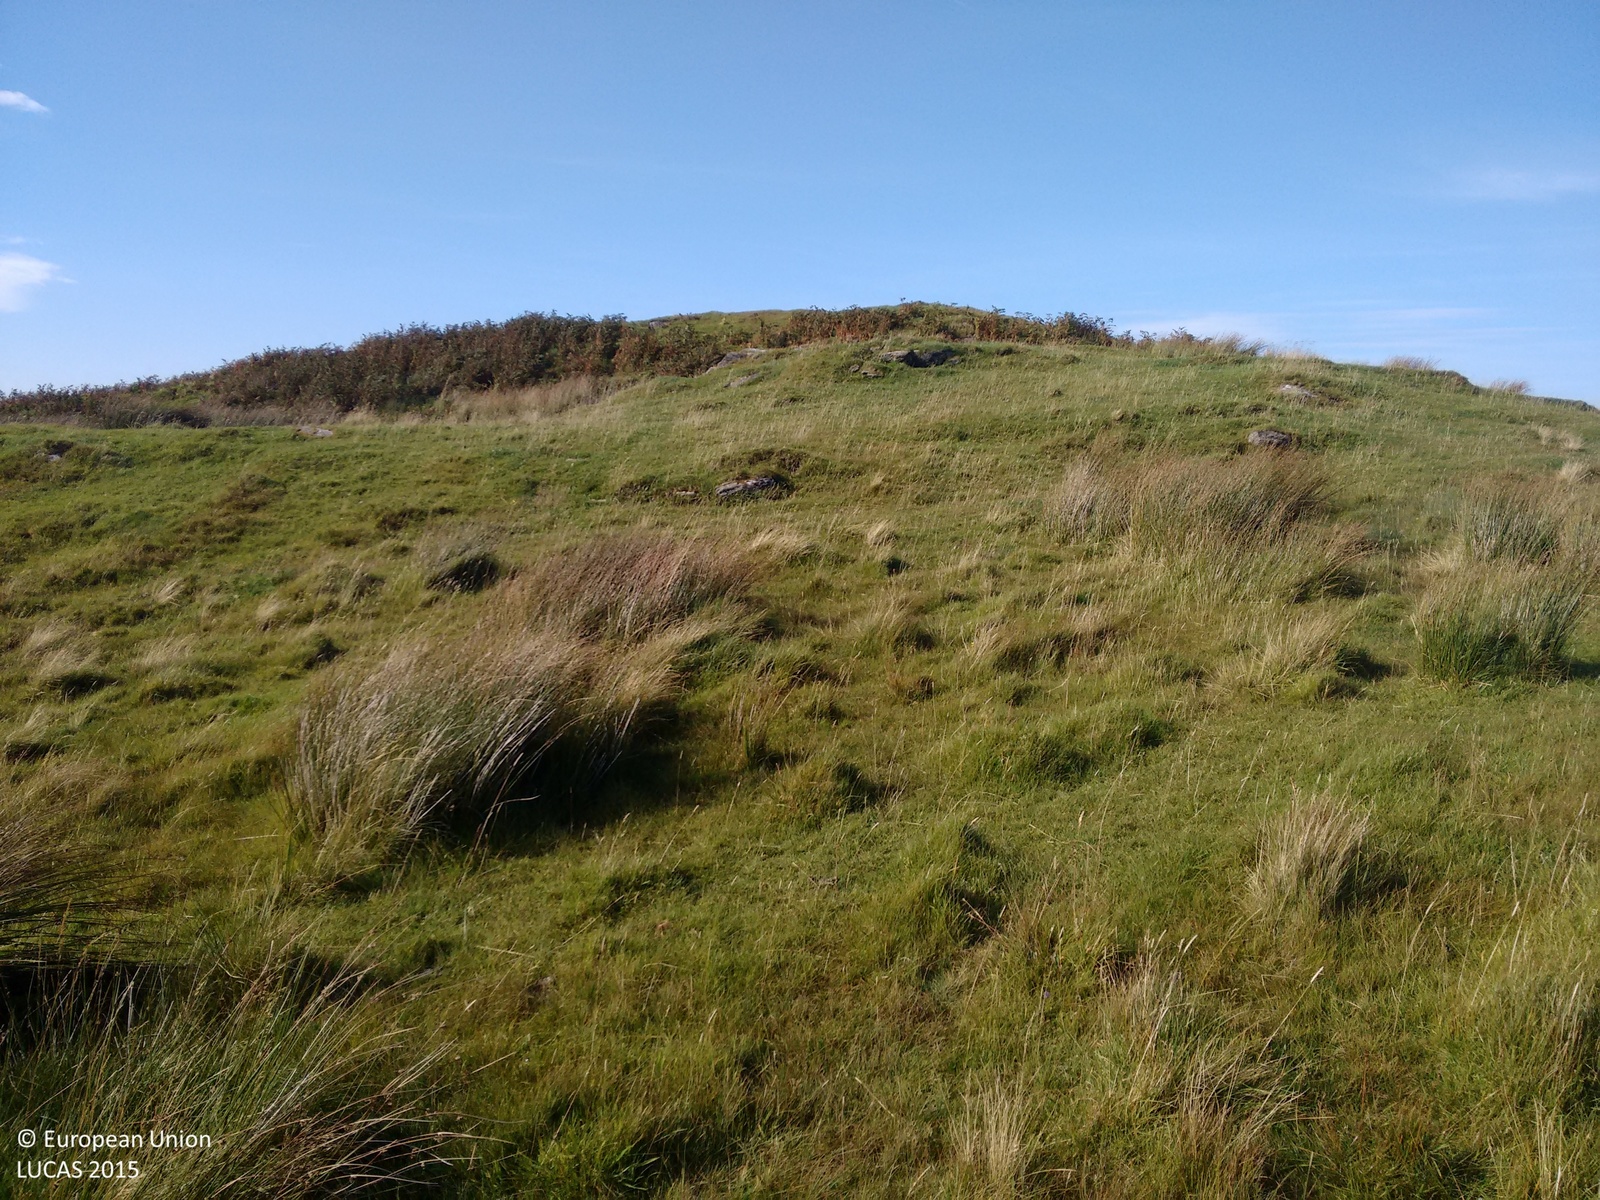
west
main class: Grassland
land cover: Grassland without tree/shrub cover
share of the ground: > 75 %
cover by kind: herbaceous plants 95 %, shrubs 5 %
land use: Agriculture (excluding fallow land and kitchen gardens)
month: September
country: GB
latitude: 56.2274
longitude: -5.6584
